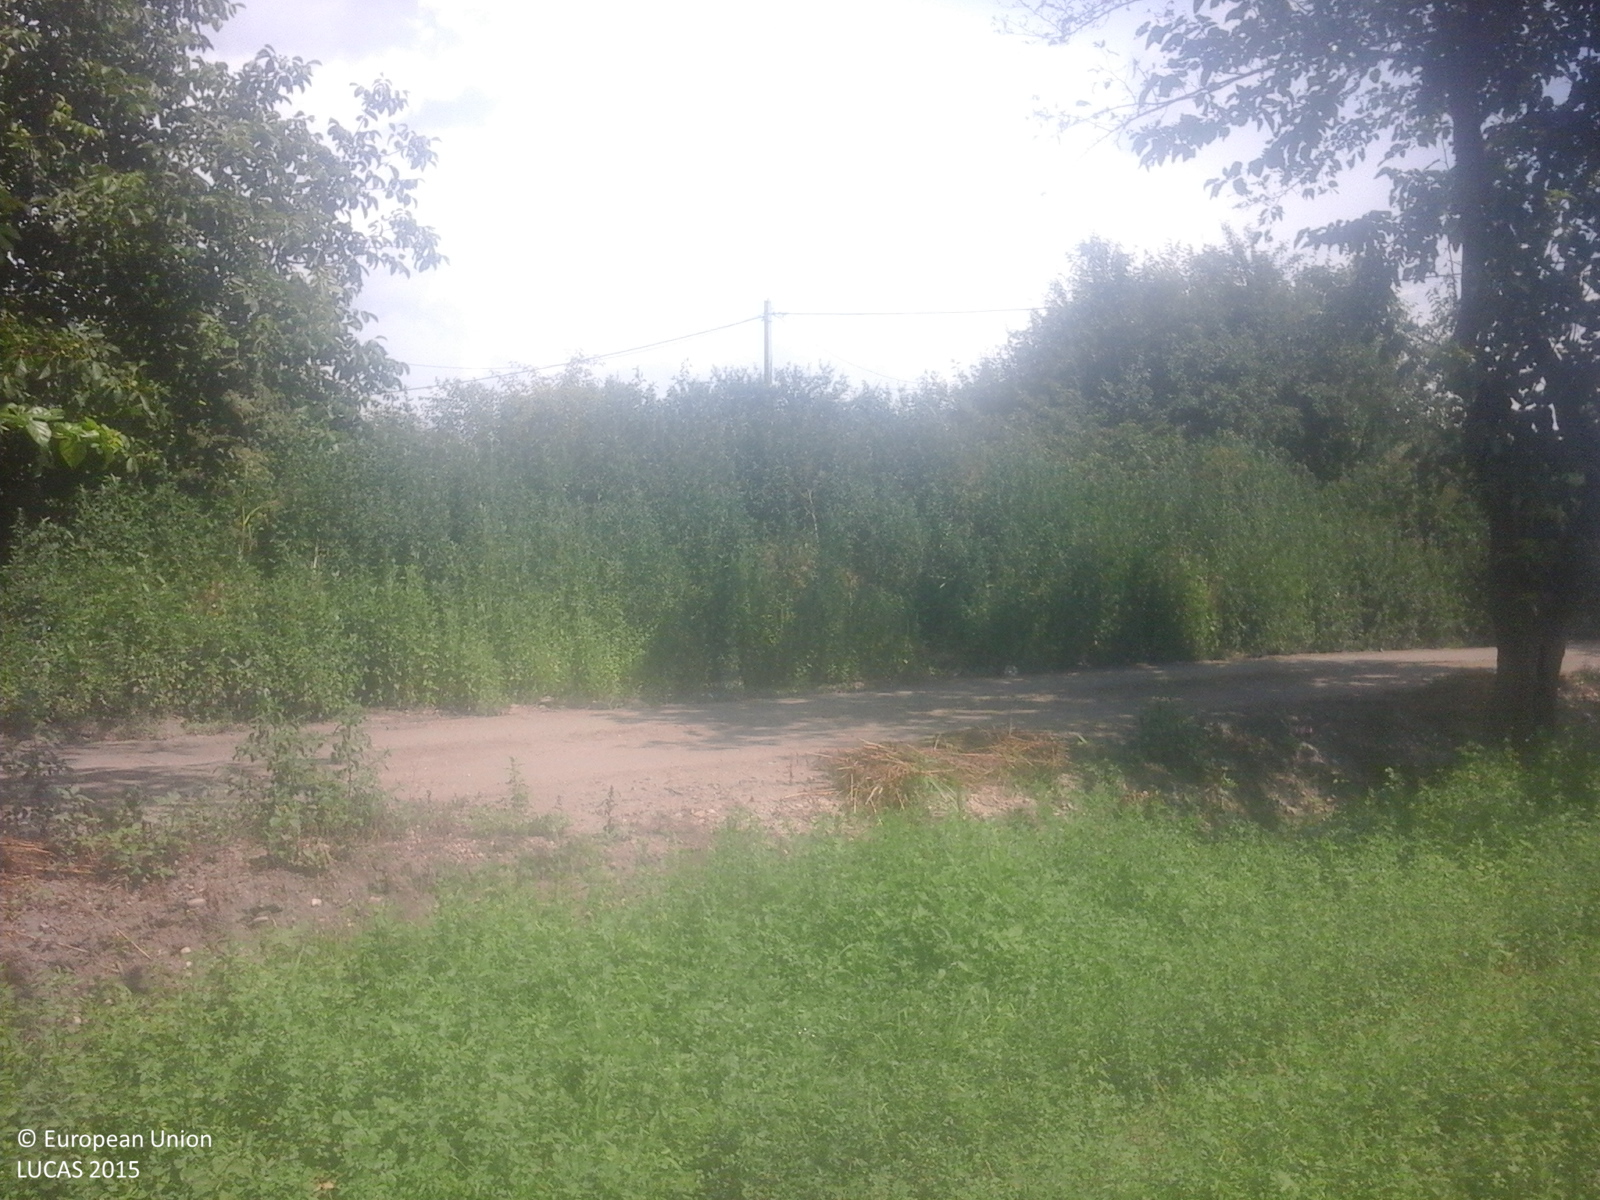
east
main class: Artificial land
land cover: Greenhouses
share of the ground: > 75 %
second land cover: Tomatoes
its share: > 75 %
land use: Agriculture (excluding fallow land and kitchen gardens)
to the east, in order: Artificial constructions in urban areas; Tomatoes; Fences; Grassland without tree/shrub cover; Lines of trees; Paved roads, cycling and walking lanes; Lines of trees; Abandoned hedges; Arable land (only in case pi); Artificial constructions in urban areas
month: July
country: RO
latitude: 43.8167
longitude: 24.6511
